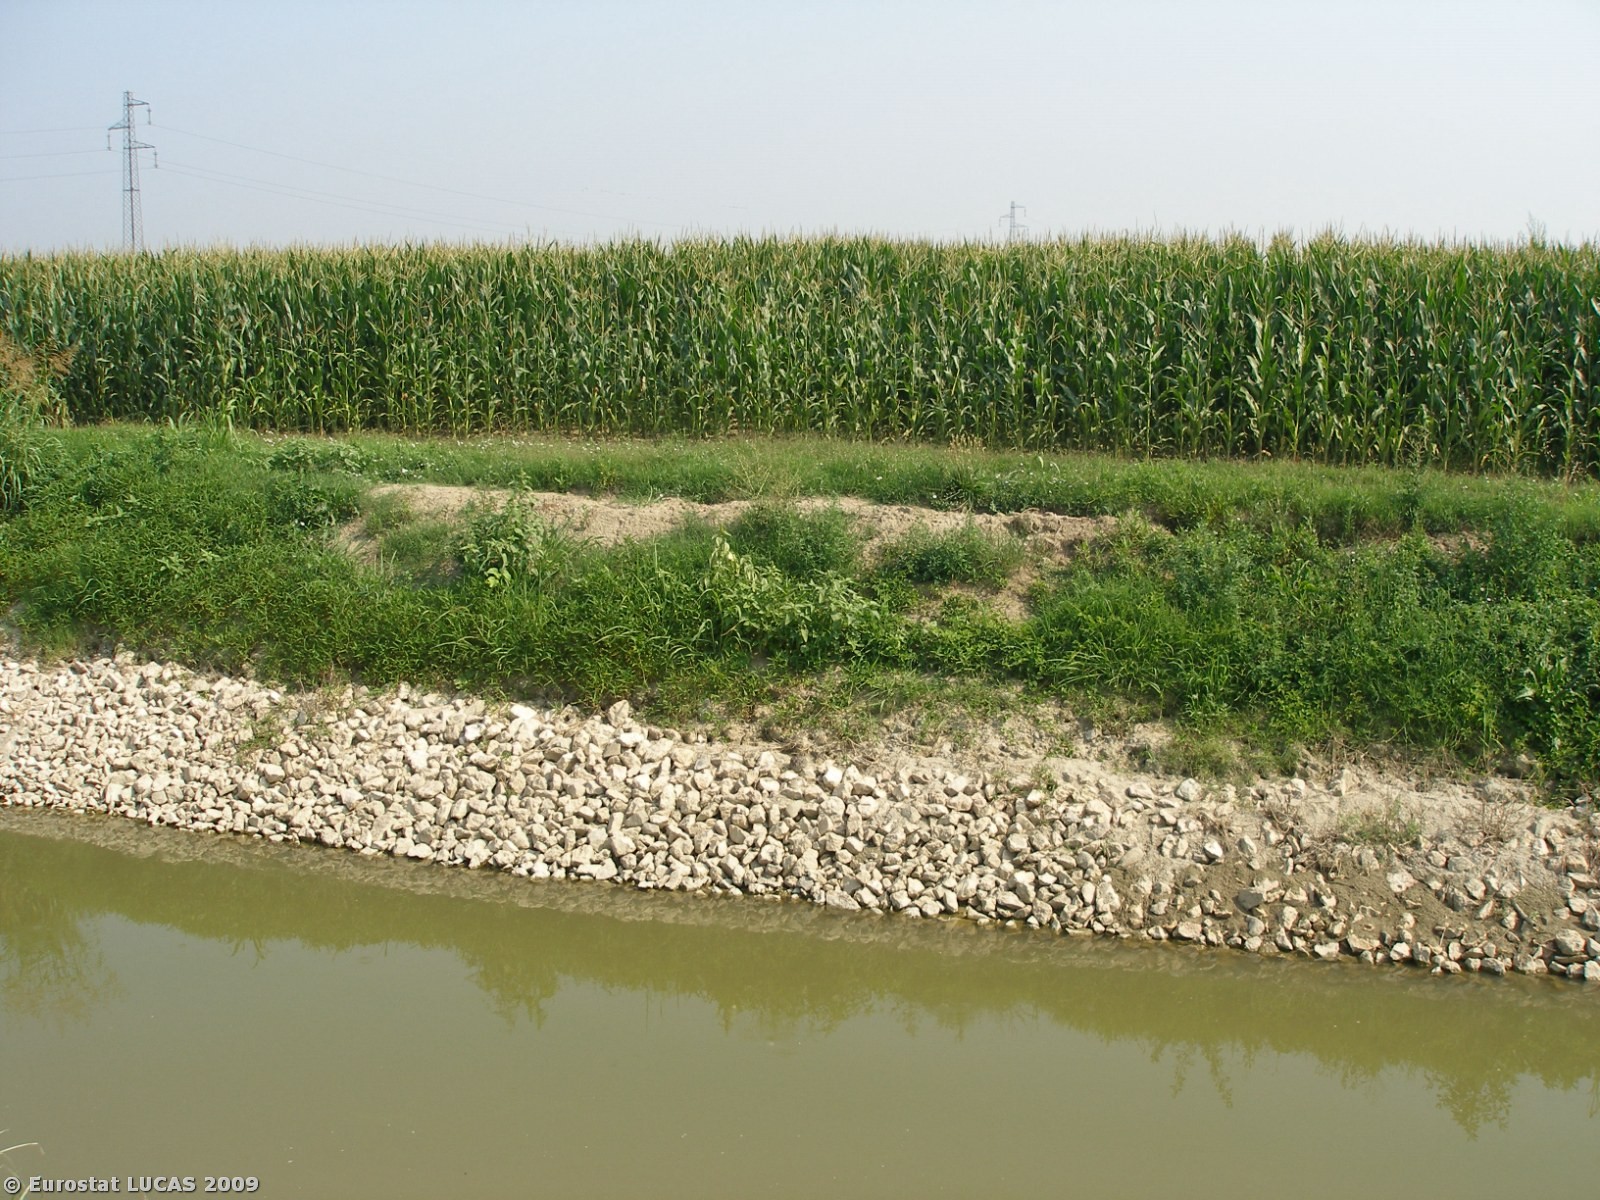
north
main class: Cropland
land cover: Maize
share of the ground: > 75 %
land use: Agriculture (excluding fallow land and kitchen gardens)
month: July
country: IT
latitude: 44.9858
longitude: 11.7089
